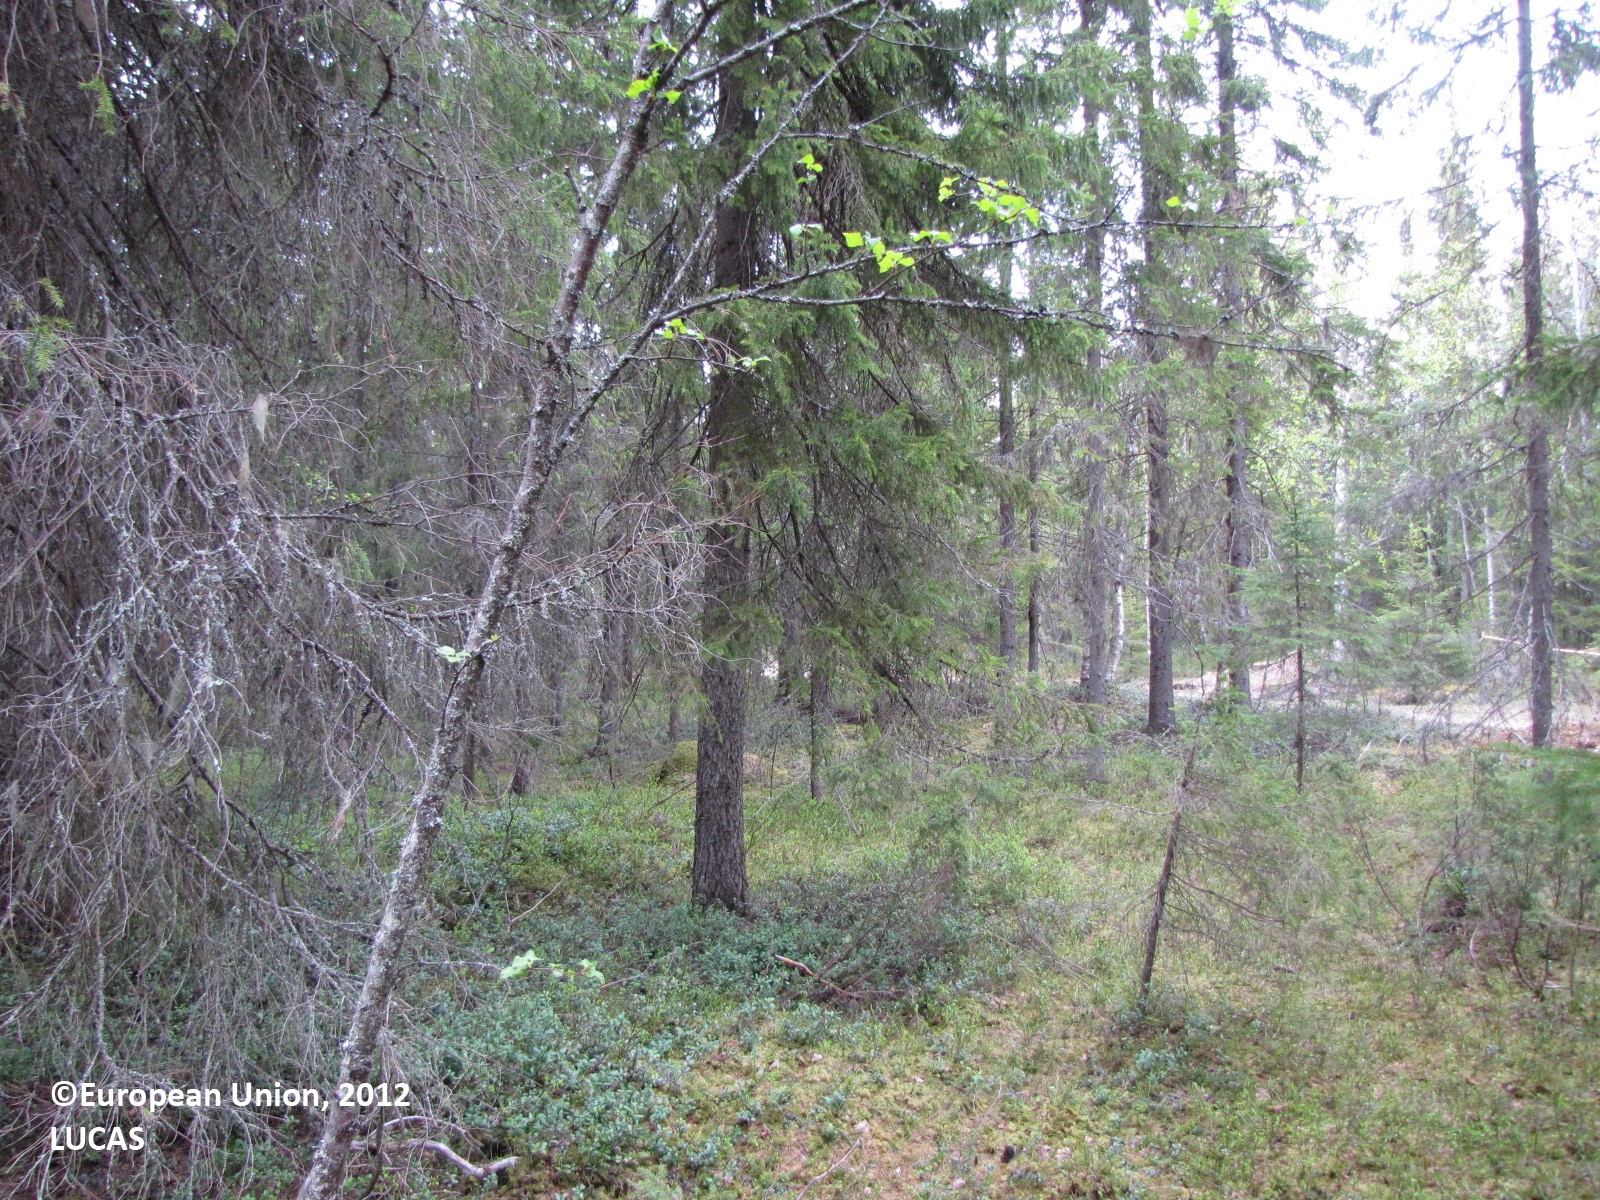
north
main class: Woodland
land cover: Spruce dominated mixed woodland
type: boreal forest
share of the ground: > 75 %
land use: Forestry
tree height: > 5 m
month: June
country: FI
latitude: 65.8323
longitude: 24.4782
